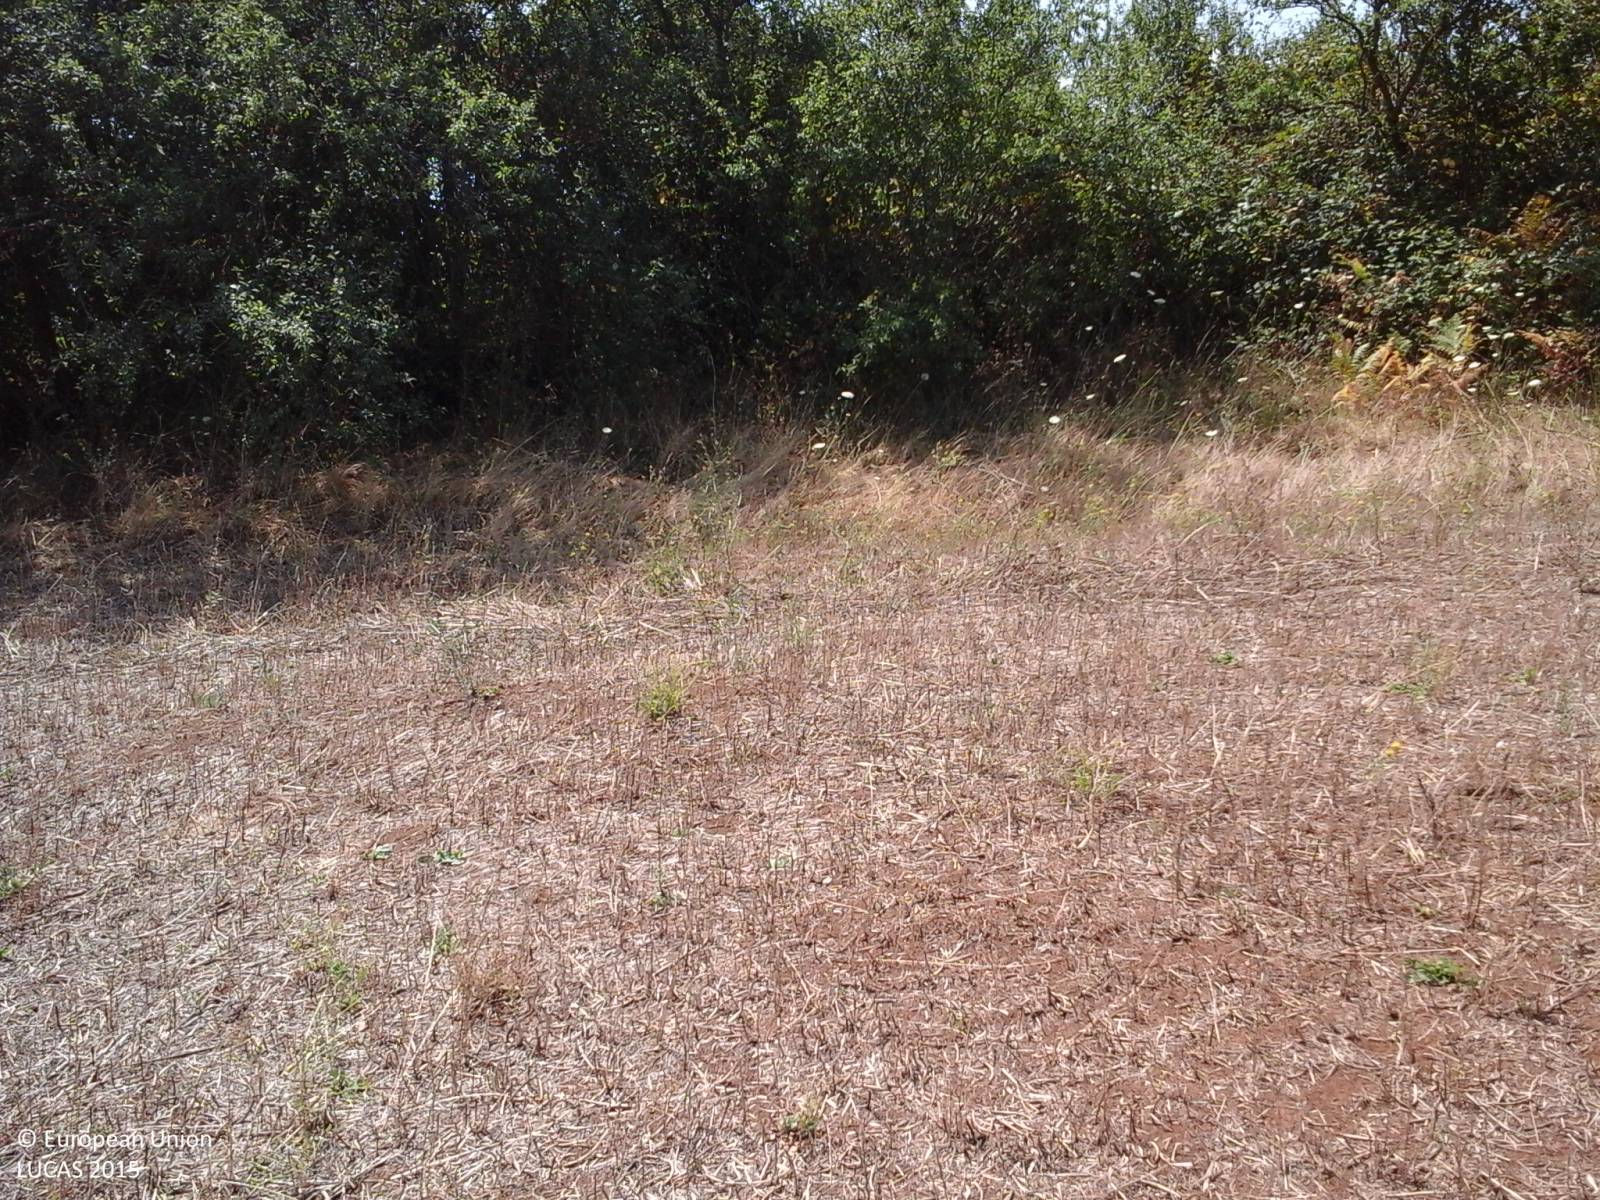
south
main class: Cropland
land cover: Temporary grasslands
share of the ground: < 10 %
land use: Agriculture (excluding fallow land and kitchen gardens)
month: July
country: IT
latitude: 42.0462
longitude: 12.4437
